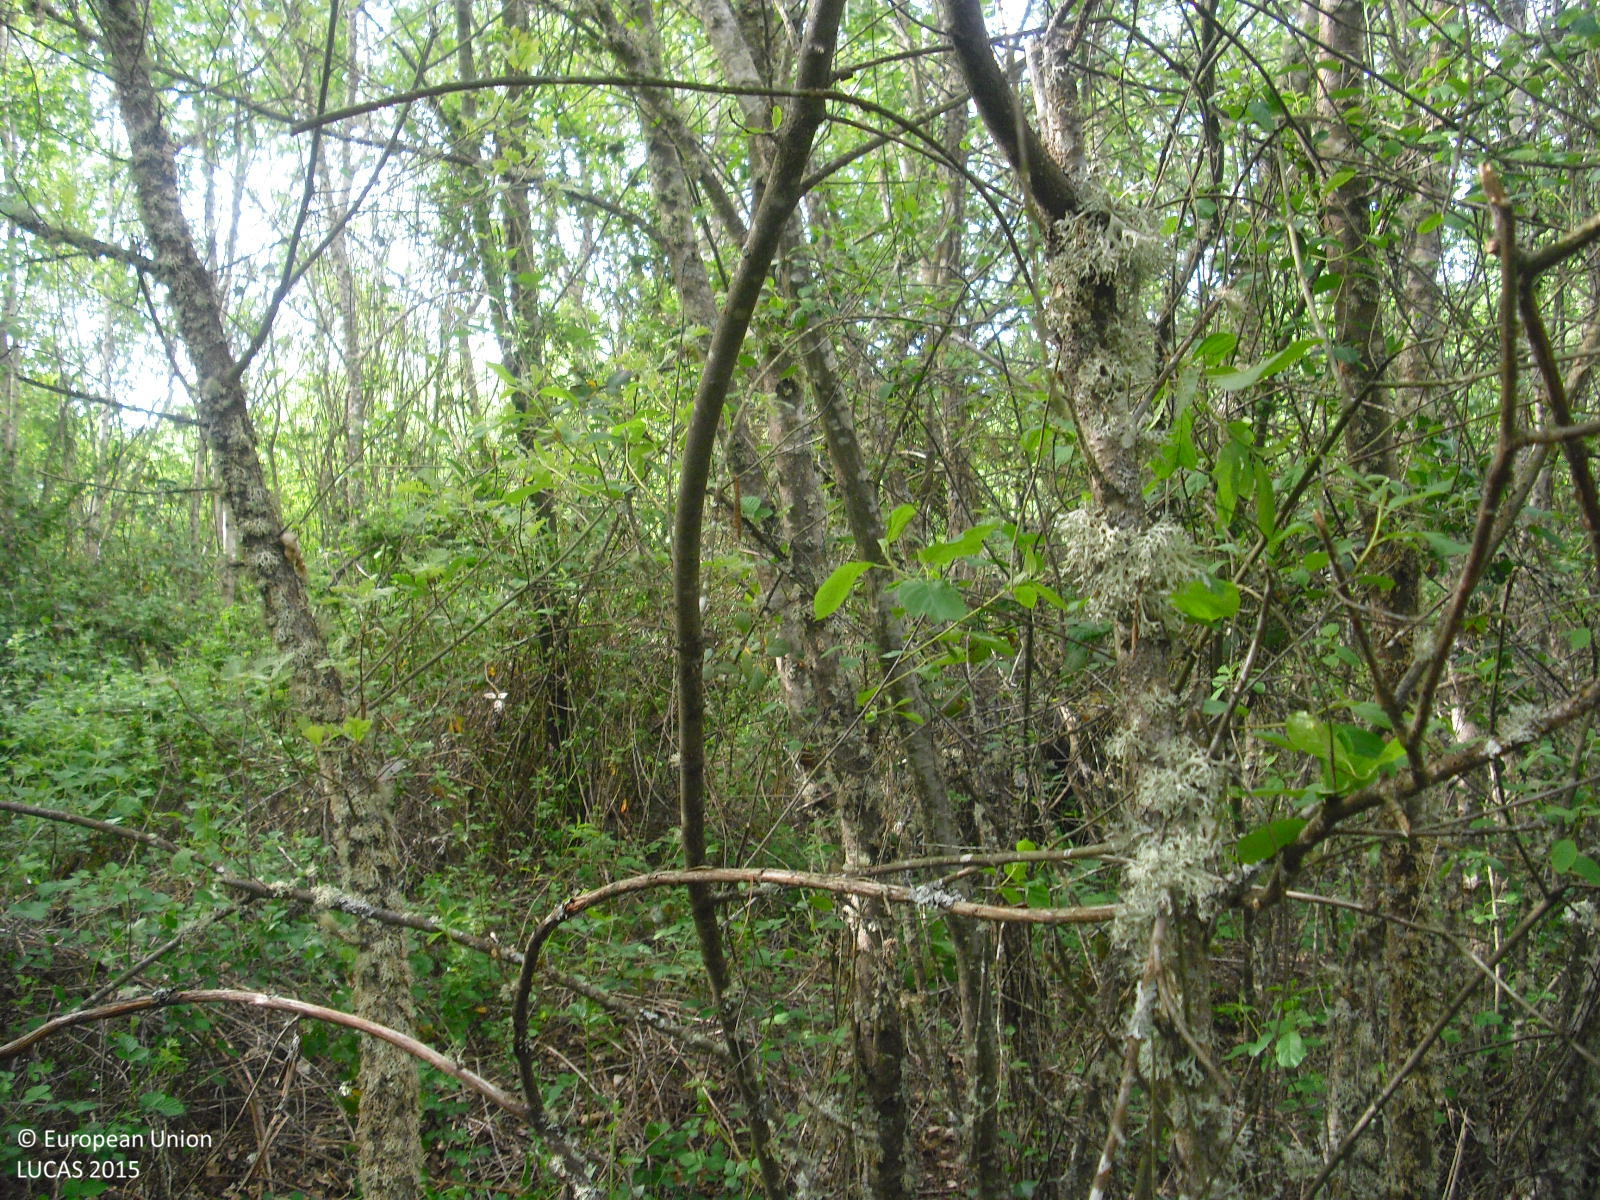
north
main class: Woodland
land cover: Broadleaved woodland
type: acidophilous oak and oak-birch forest
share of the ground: > 75 %
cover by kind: broadleaved forest trees 80 %, shrubs 20 %
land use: Semi-natural and natural areas not in use
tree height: > 5 m
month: May
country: ES
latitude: 42.1717
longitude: -7.6831
